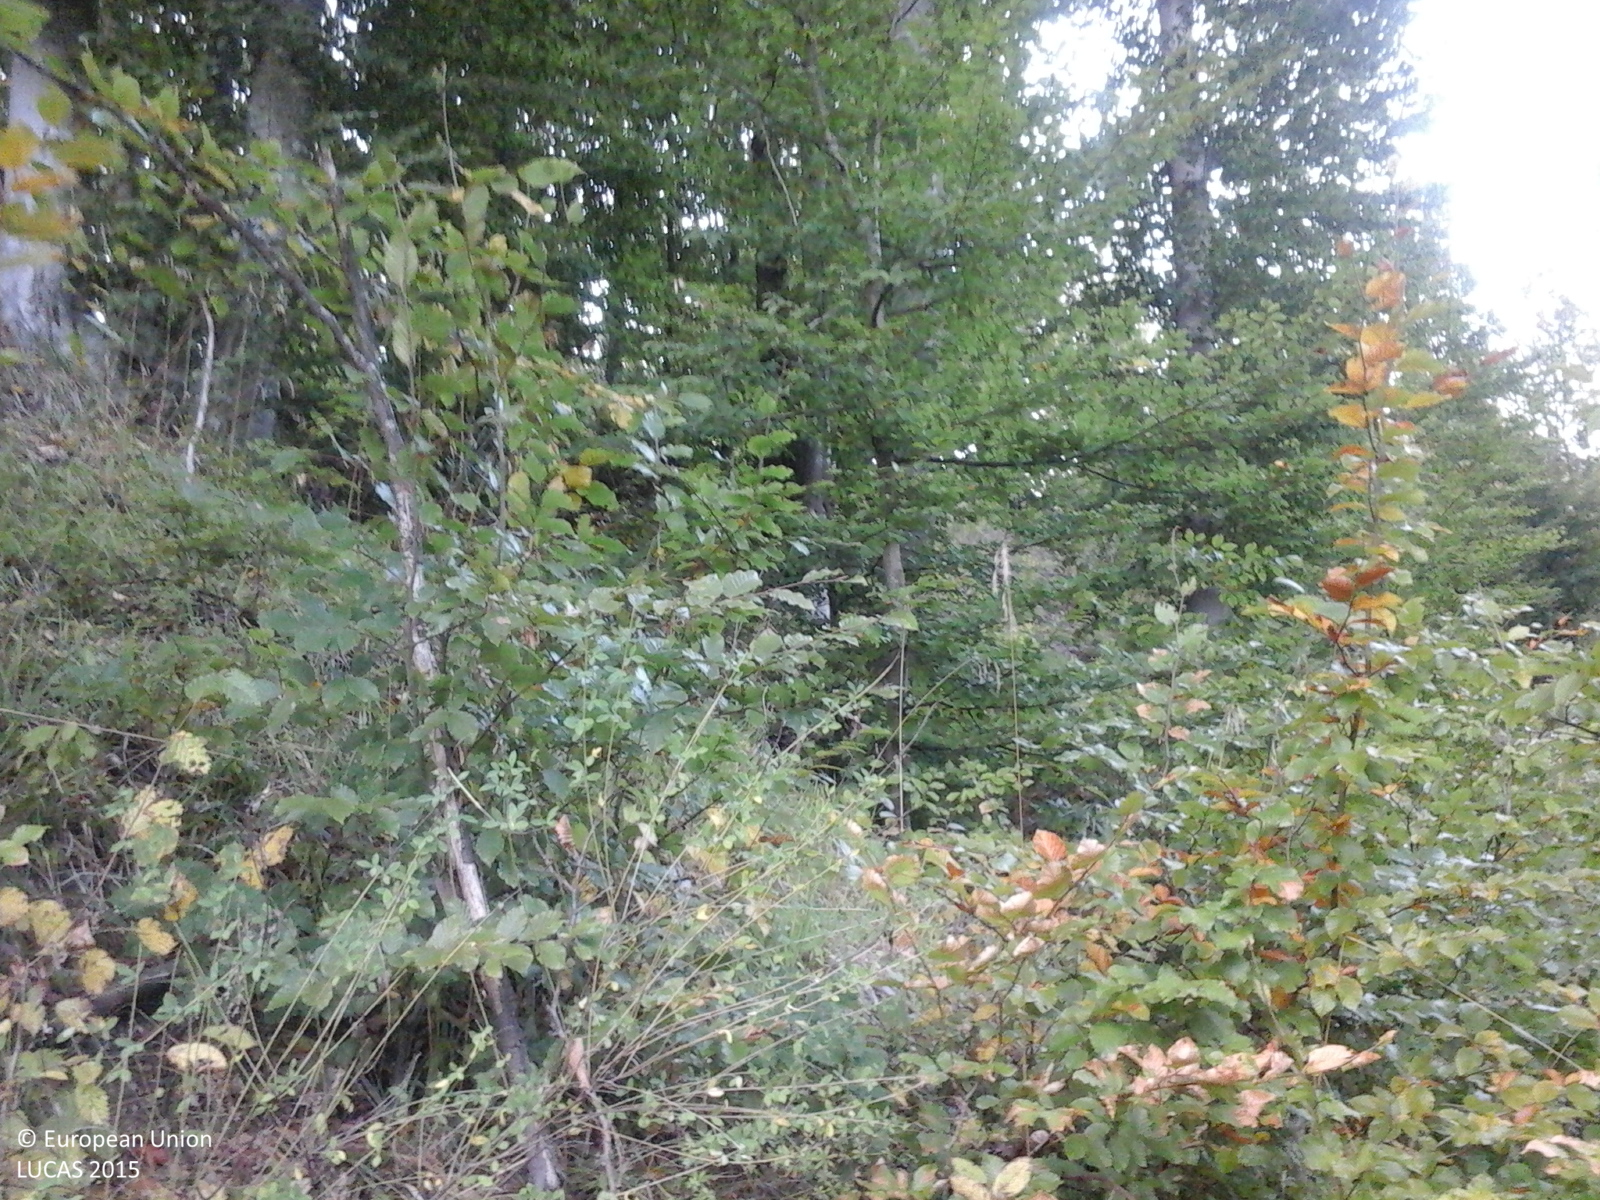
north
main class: Woodland
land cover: Broadleaved woodland
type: acidophilous oak and oak-birch forest
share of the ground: > 75 %
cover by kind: broadleaved forest trees 100 %
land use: Forestry
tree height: > 5 m
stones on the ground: < 10 %
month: September
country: RO
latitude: 45.7185
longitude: 22.0789
